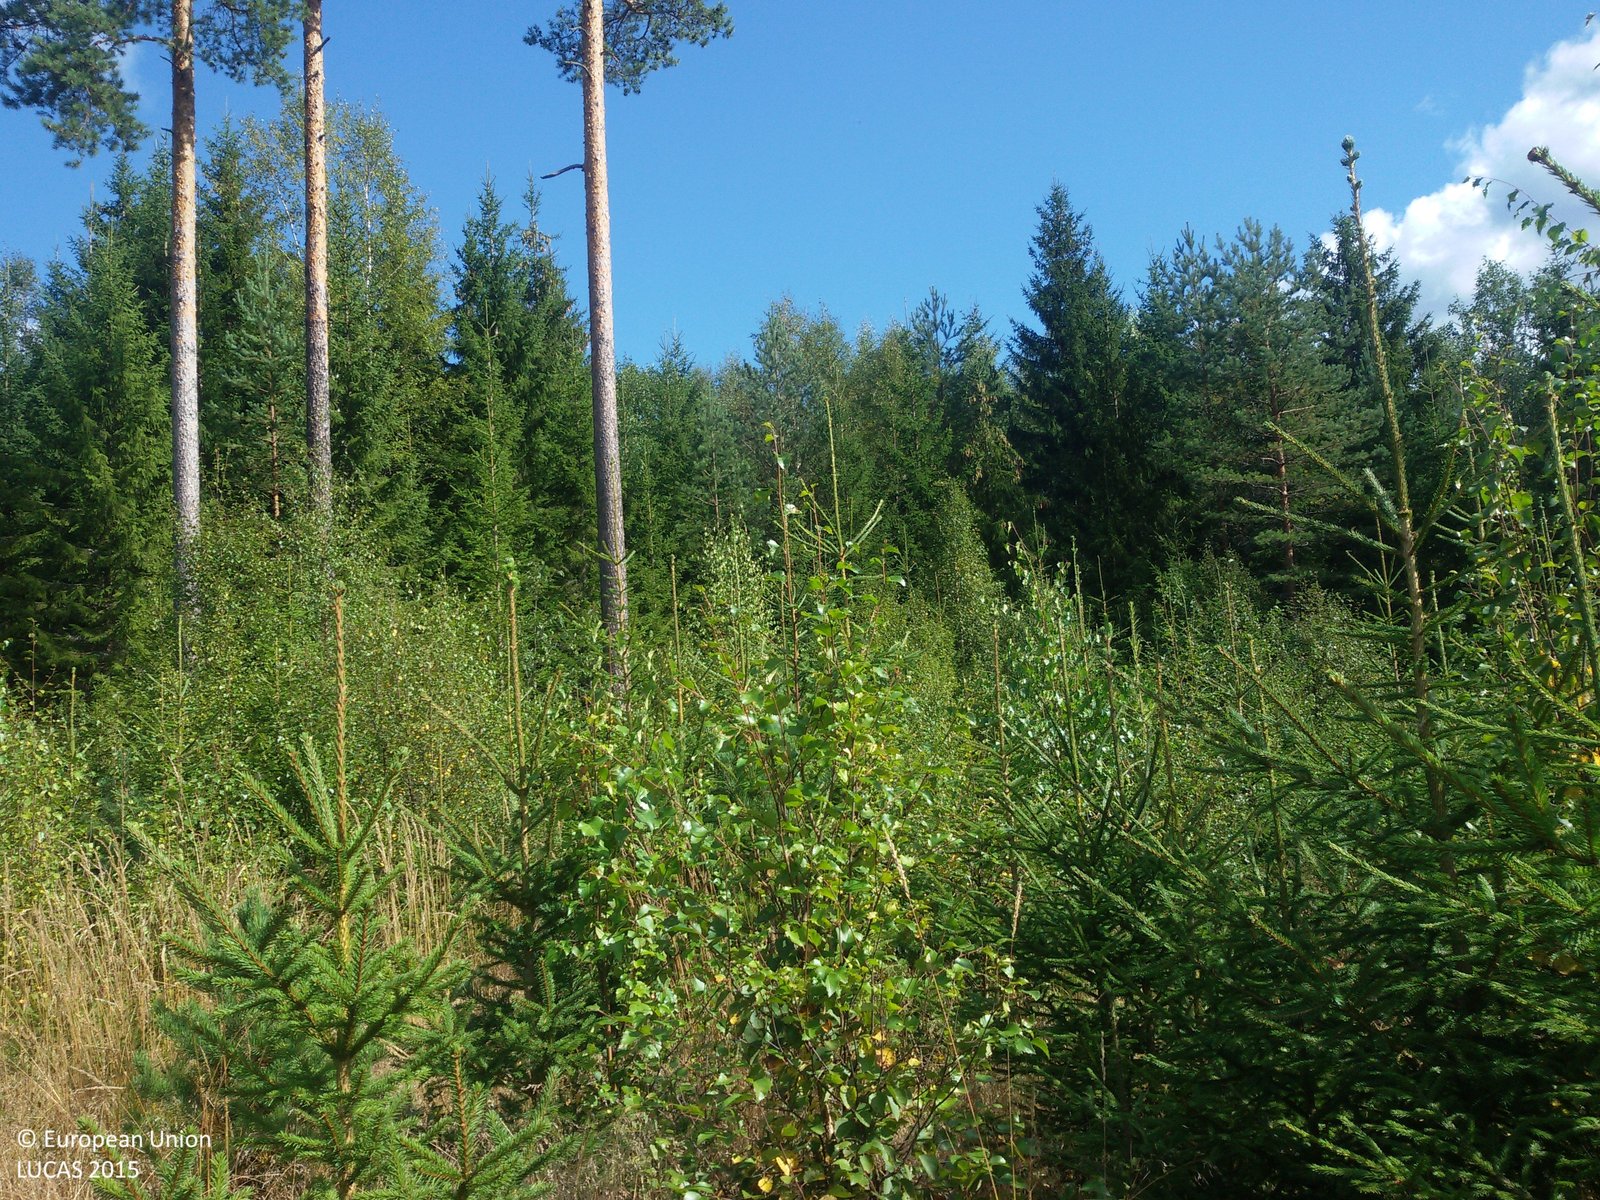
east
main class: Woodland
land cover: Spruce dominated mixed woodland
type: boreal forest
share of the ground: 50 - 75 %
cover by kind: herbaceous plants 45 %, coniferous forest trees 35 %, broadleaved forest trees 20 %
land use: Forestry
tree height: < 5 m
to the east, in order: Spruce dominated mixed woodland; Spruce dominated coniferous woodland; Pine dominated mixed woodland; Ditches and canals; Spruce dominated coniferous woodland; Pine dominated coniferous woodland
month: August
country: SE
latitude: 60.6637
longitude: 15.6412
